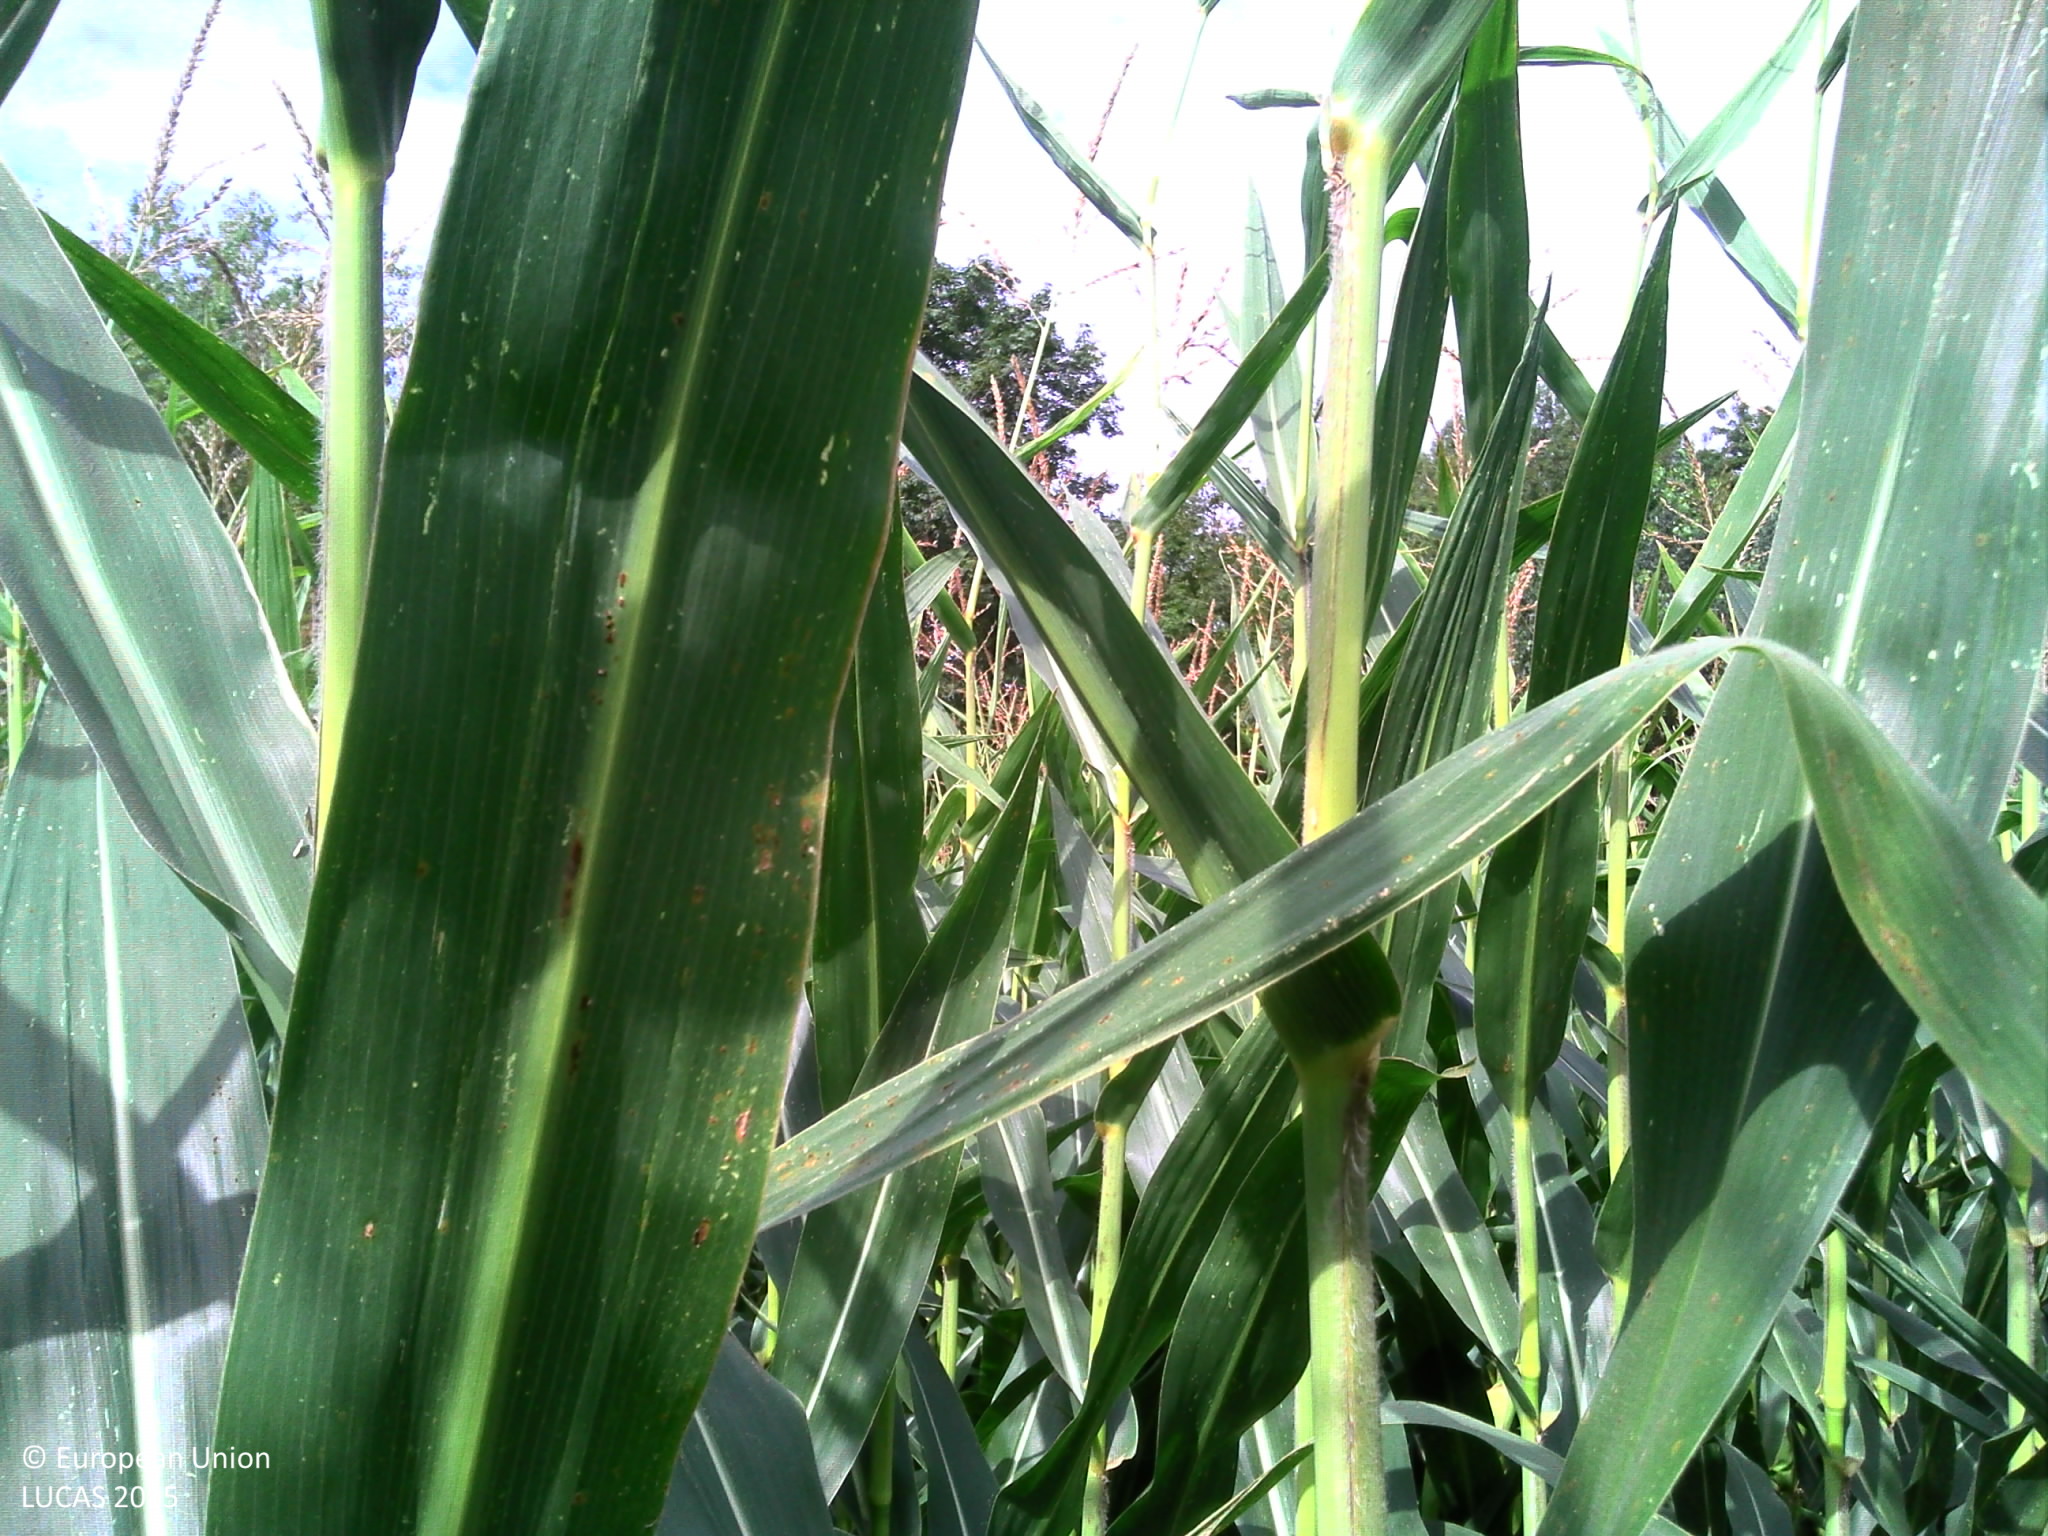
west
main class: Cropland
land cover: Maize
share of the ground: > 75 %
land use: Agriculture (excluding fallow land and kitchen gardens)
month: September
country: FR
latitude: 43.5743
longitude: -0.1983
